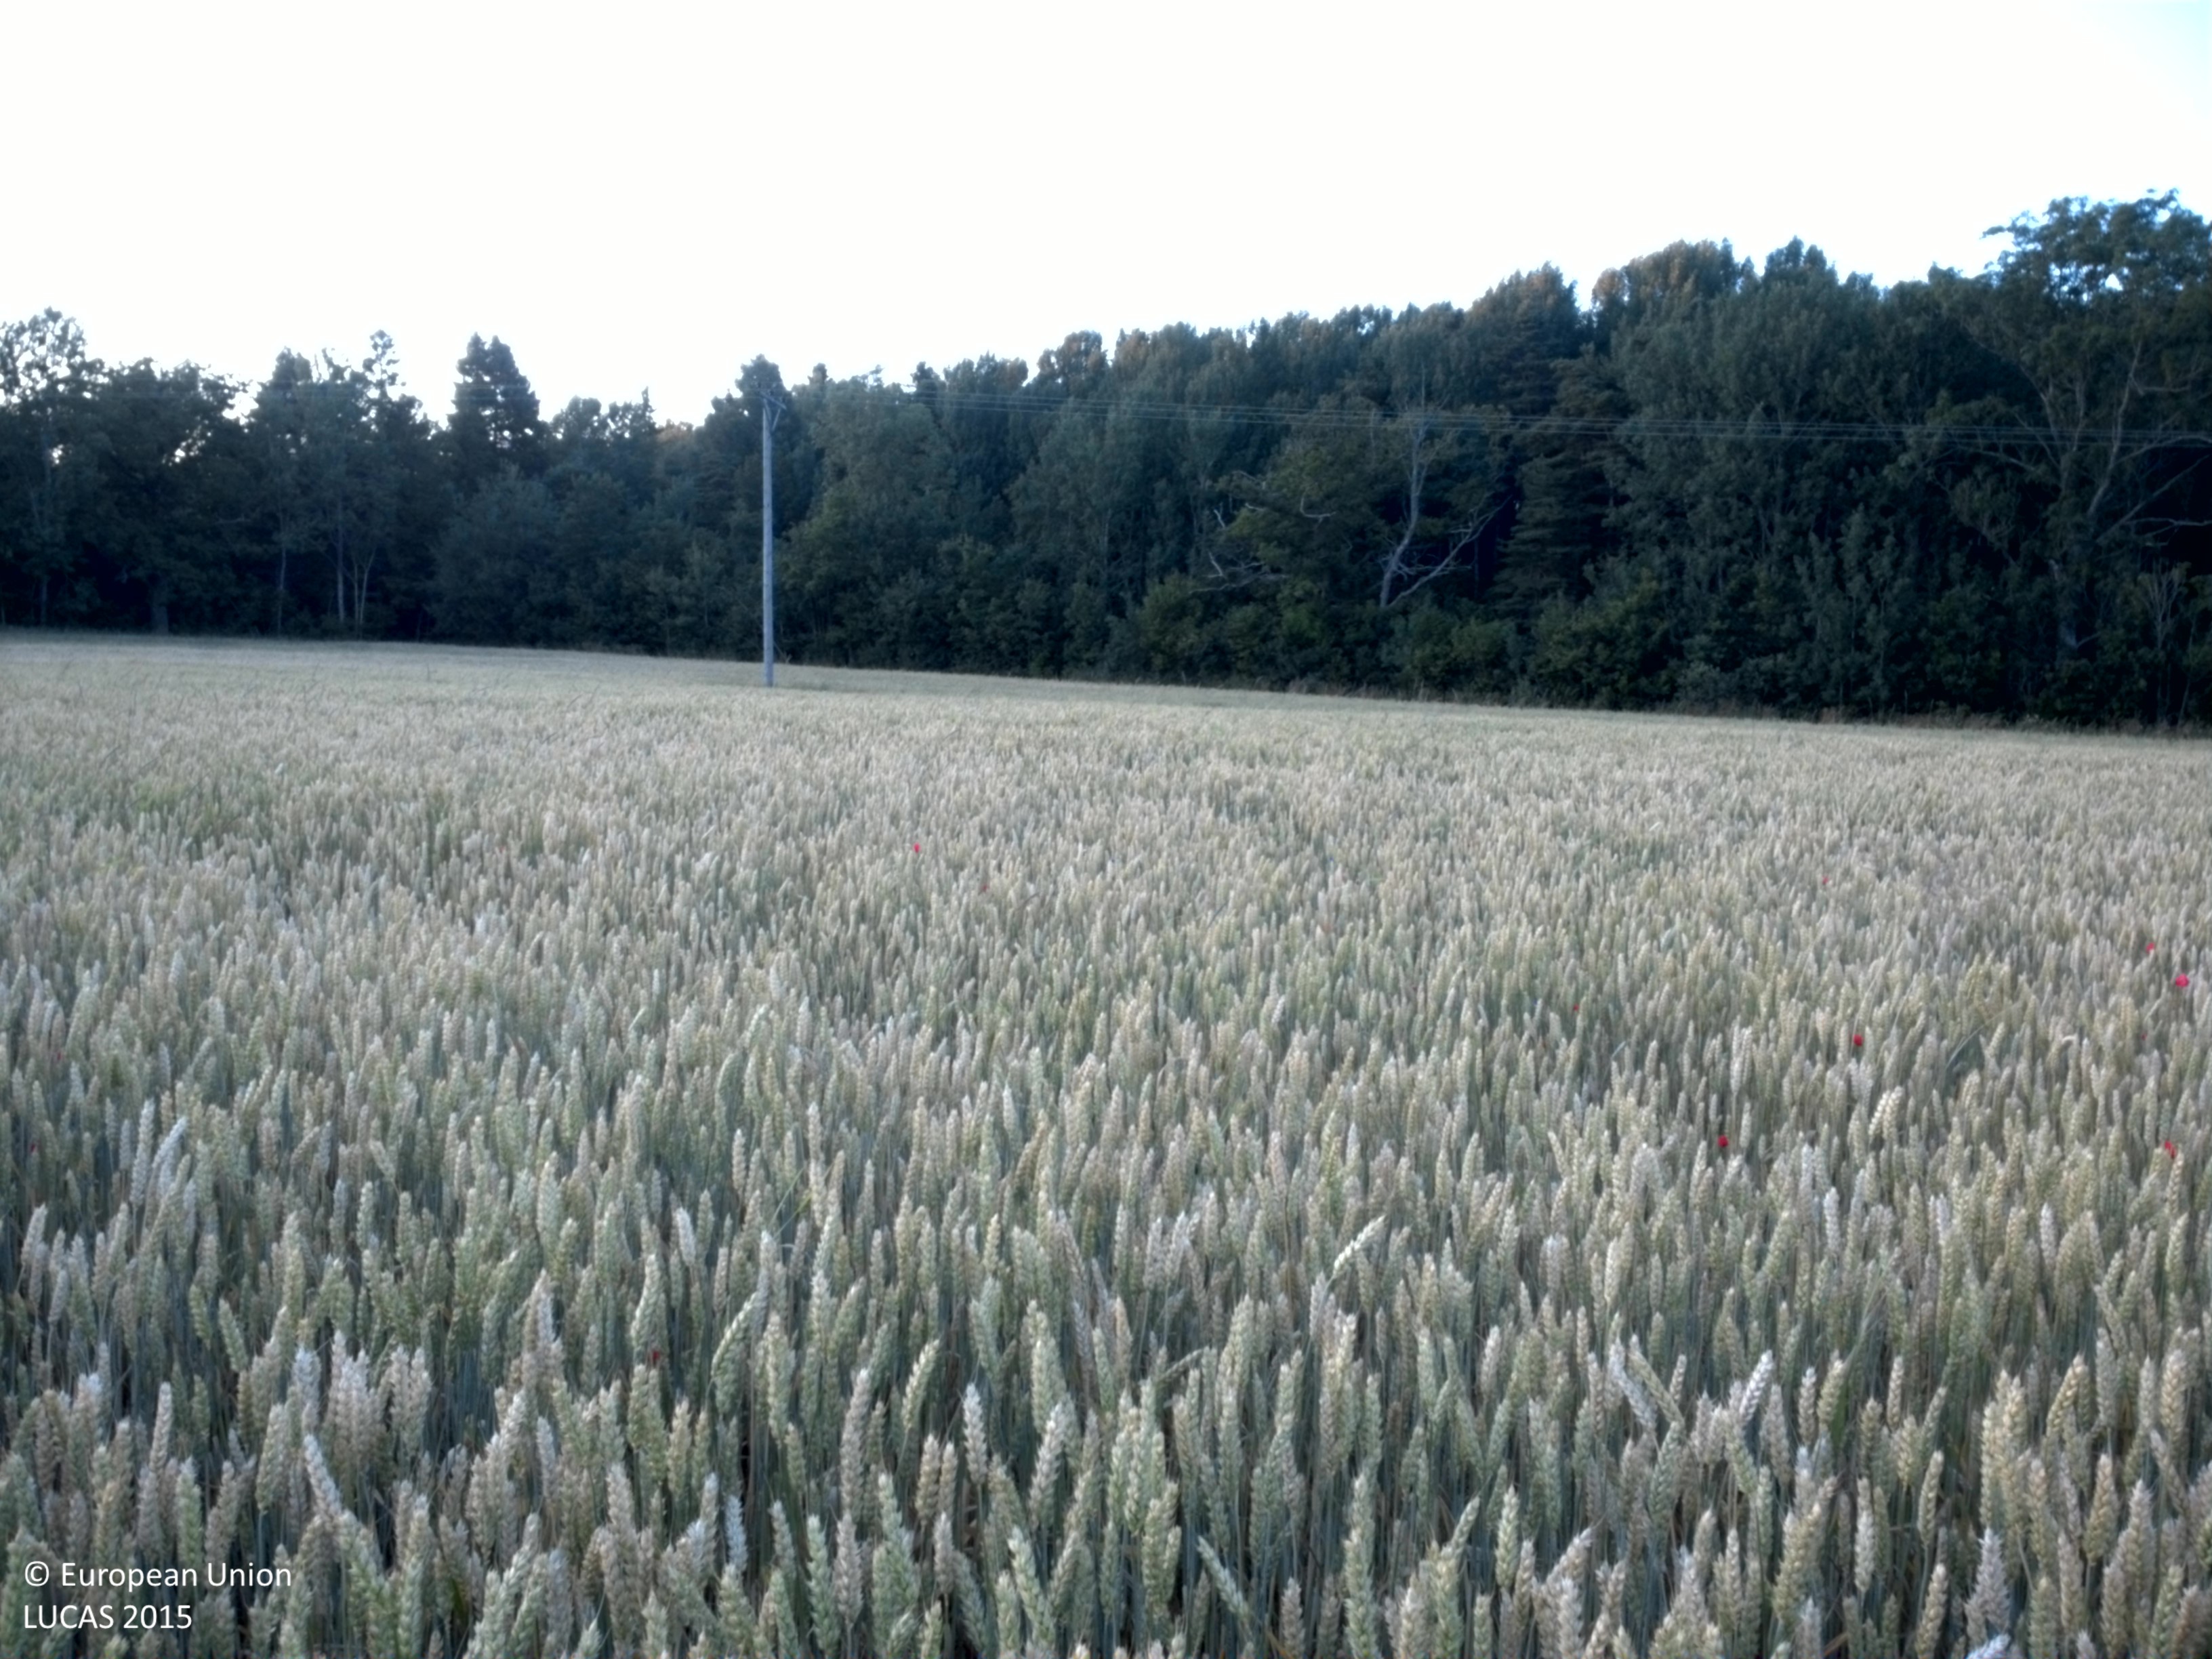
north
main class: Cropland
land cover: Common wheat
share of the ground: > 75 %
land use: Agriculture (excluding fallow land and kitchen gardens)
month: July
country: SE
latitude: 57.2835
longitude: 18.4529
